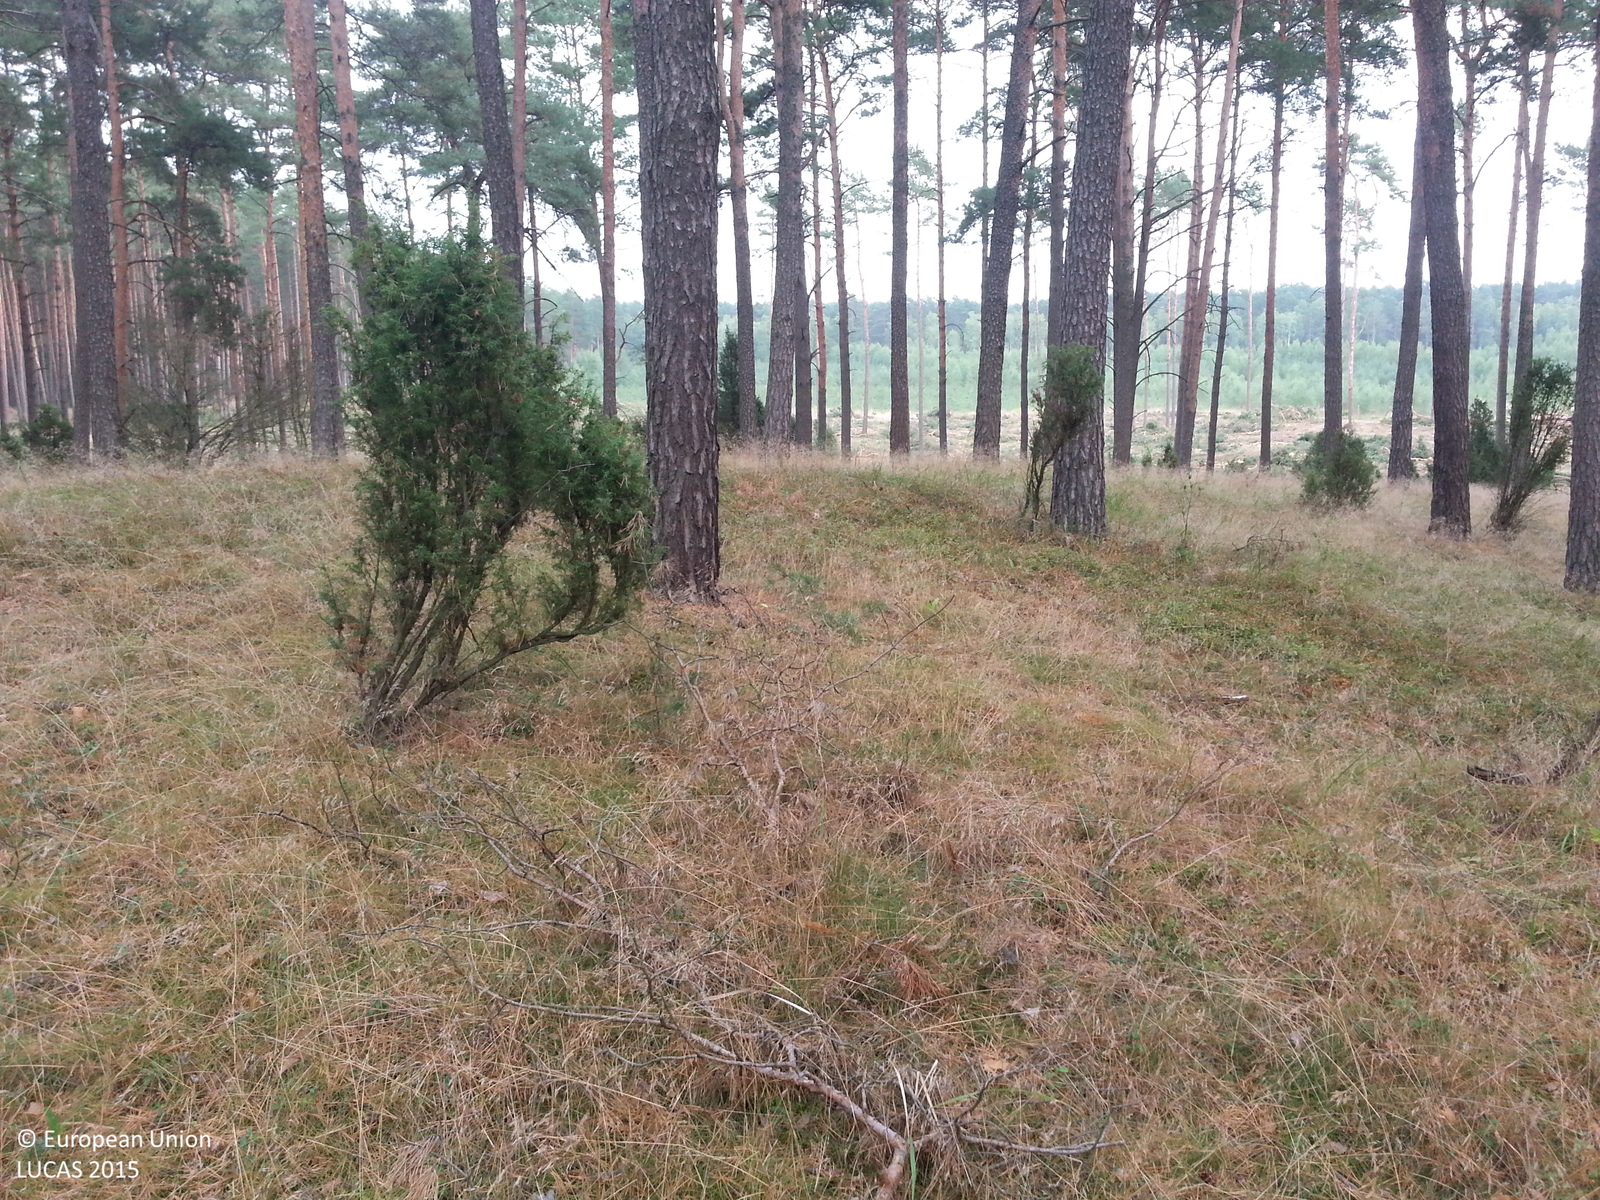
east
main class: Woodland
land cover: Pine dominated coniferous woodland
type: hemiboreal forest and nemoral coniferous forest and mixed broadleaved-coniferous forest
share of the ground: 50 - 75 %
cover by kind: coniferous forest trees 70 %, herbaceous plants 20 %, lichens and mosses 10 %
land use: Forestry
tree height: > 5 m
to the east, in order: Pine dominated coniferous woodland; Fences; Pine dominated coniferous woodland; Fences; Pine dominated coniferous woodland
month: September
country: PL
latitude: 53.0034
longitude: 18.1076
